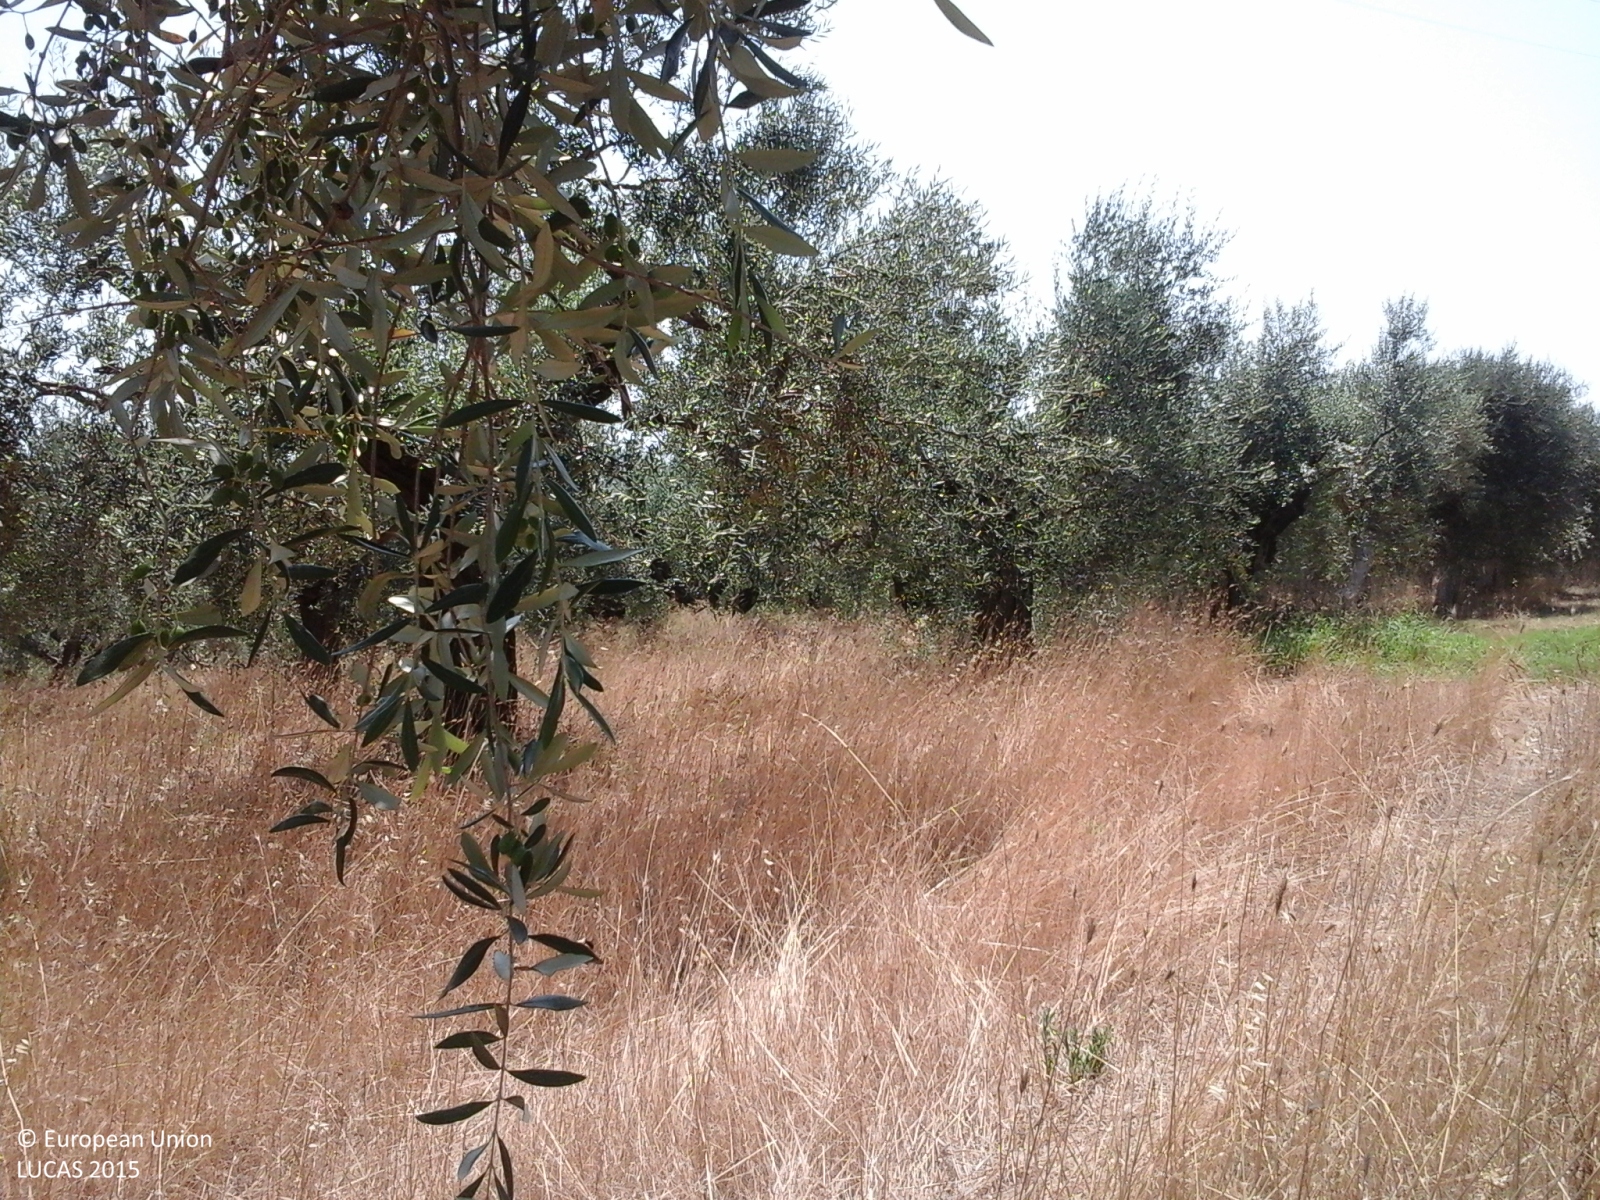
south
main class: Cropland
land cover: Olive groves
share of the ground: 50 - 75 %
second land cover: Grassland without tree/shrub cover
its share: 50 - 75 %
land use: Agriculture (excluding fallow land and kitchen gardens)
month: July
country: IT
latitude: 42.4266
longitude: 11.4656
